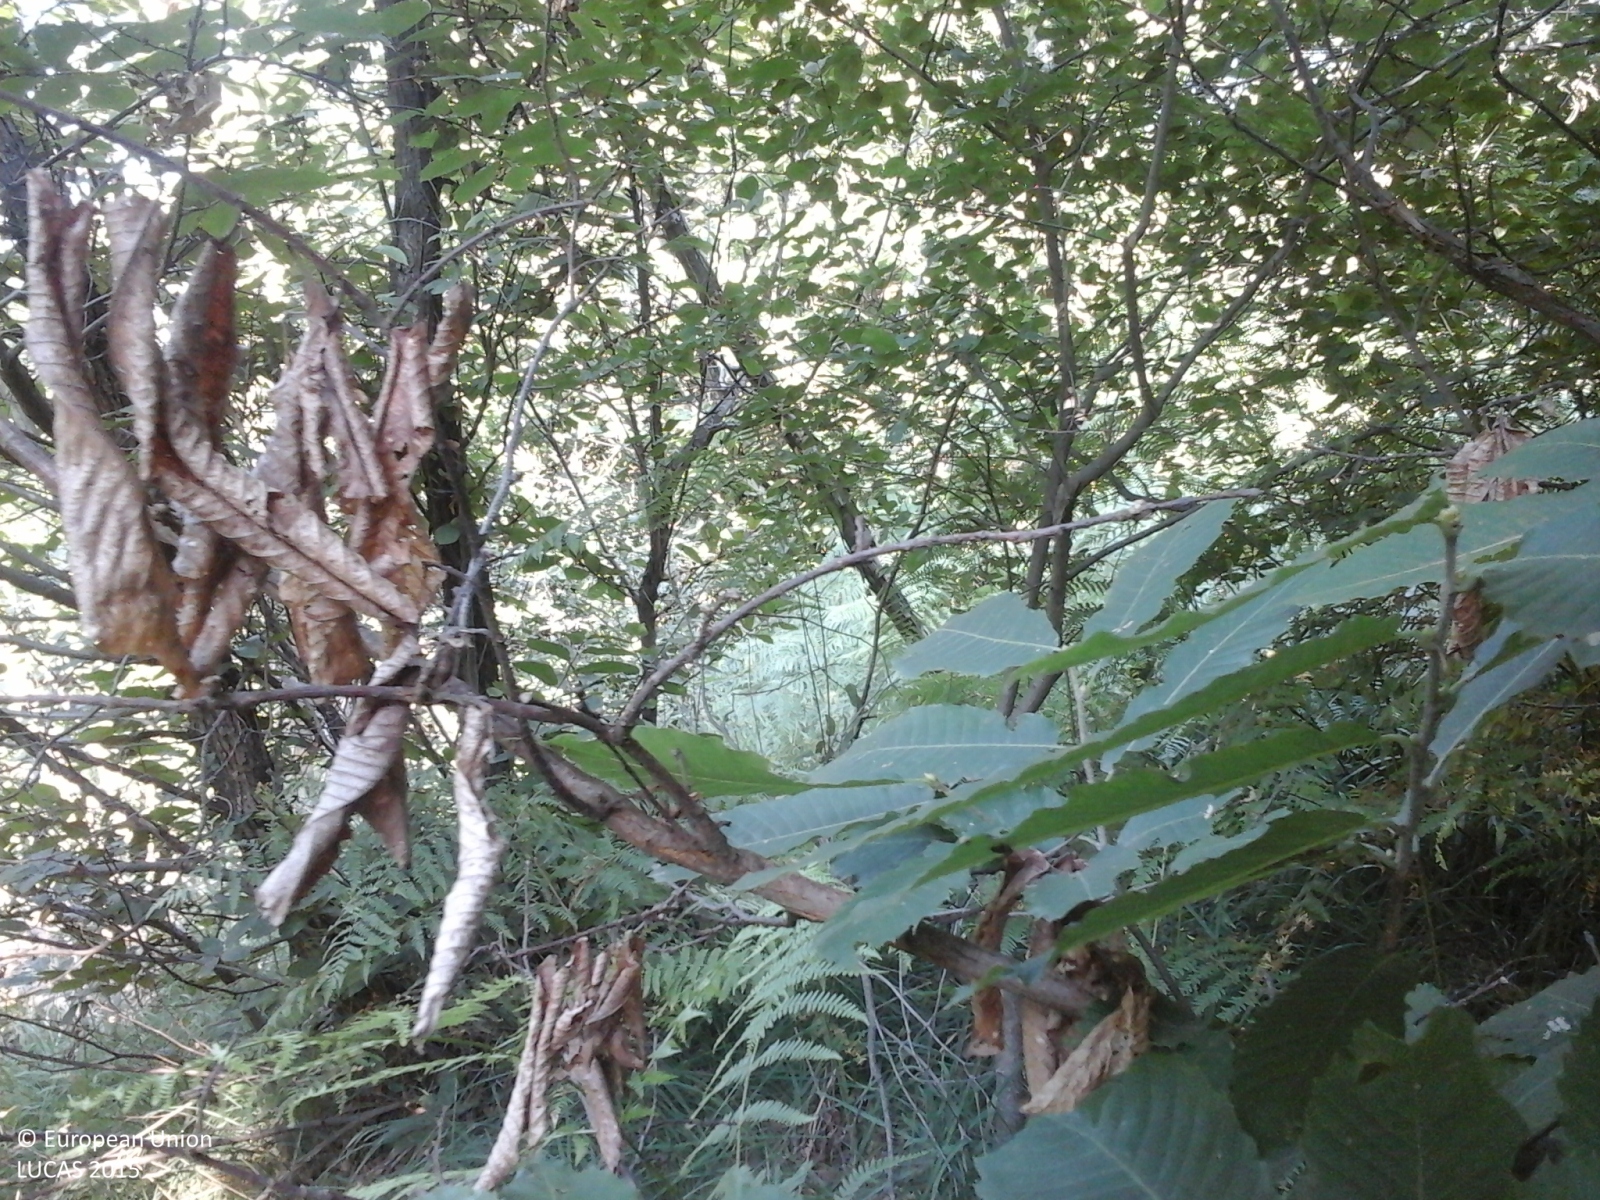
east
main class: Woodland
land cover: Broadleaved woodland
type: thermophilous deciduous forest
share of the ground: > 75 %
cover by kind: broadleaved forest trees 100 %
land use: Semi-natural and natural areas not in use
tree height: > 5 m
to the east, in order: Broadleaved woodland; Ditches and canals; Broadleaved woodland
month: July
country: IT
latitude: 44.8563
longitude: 7.2842
